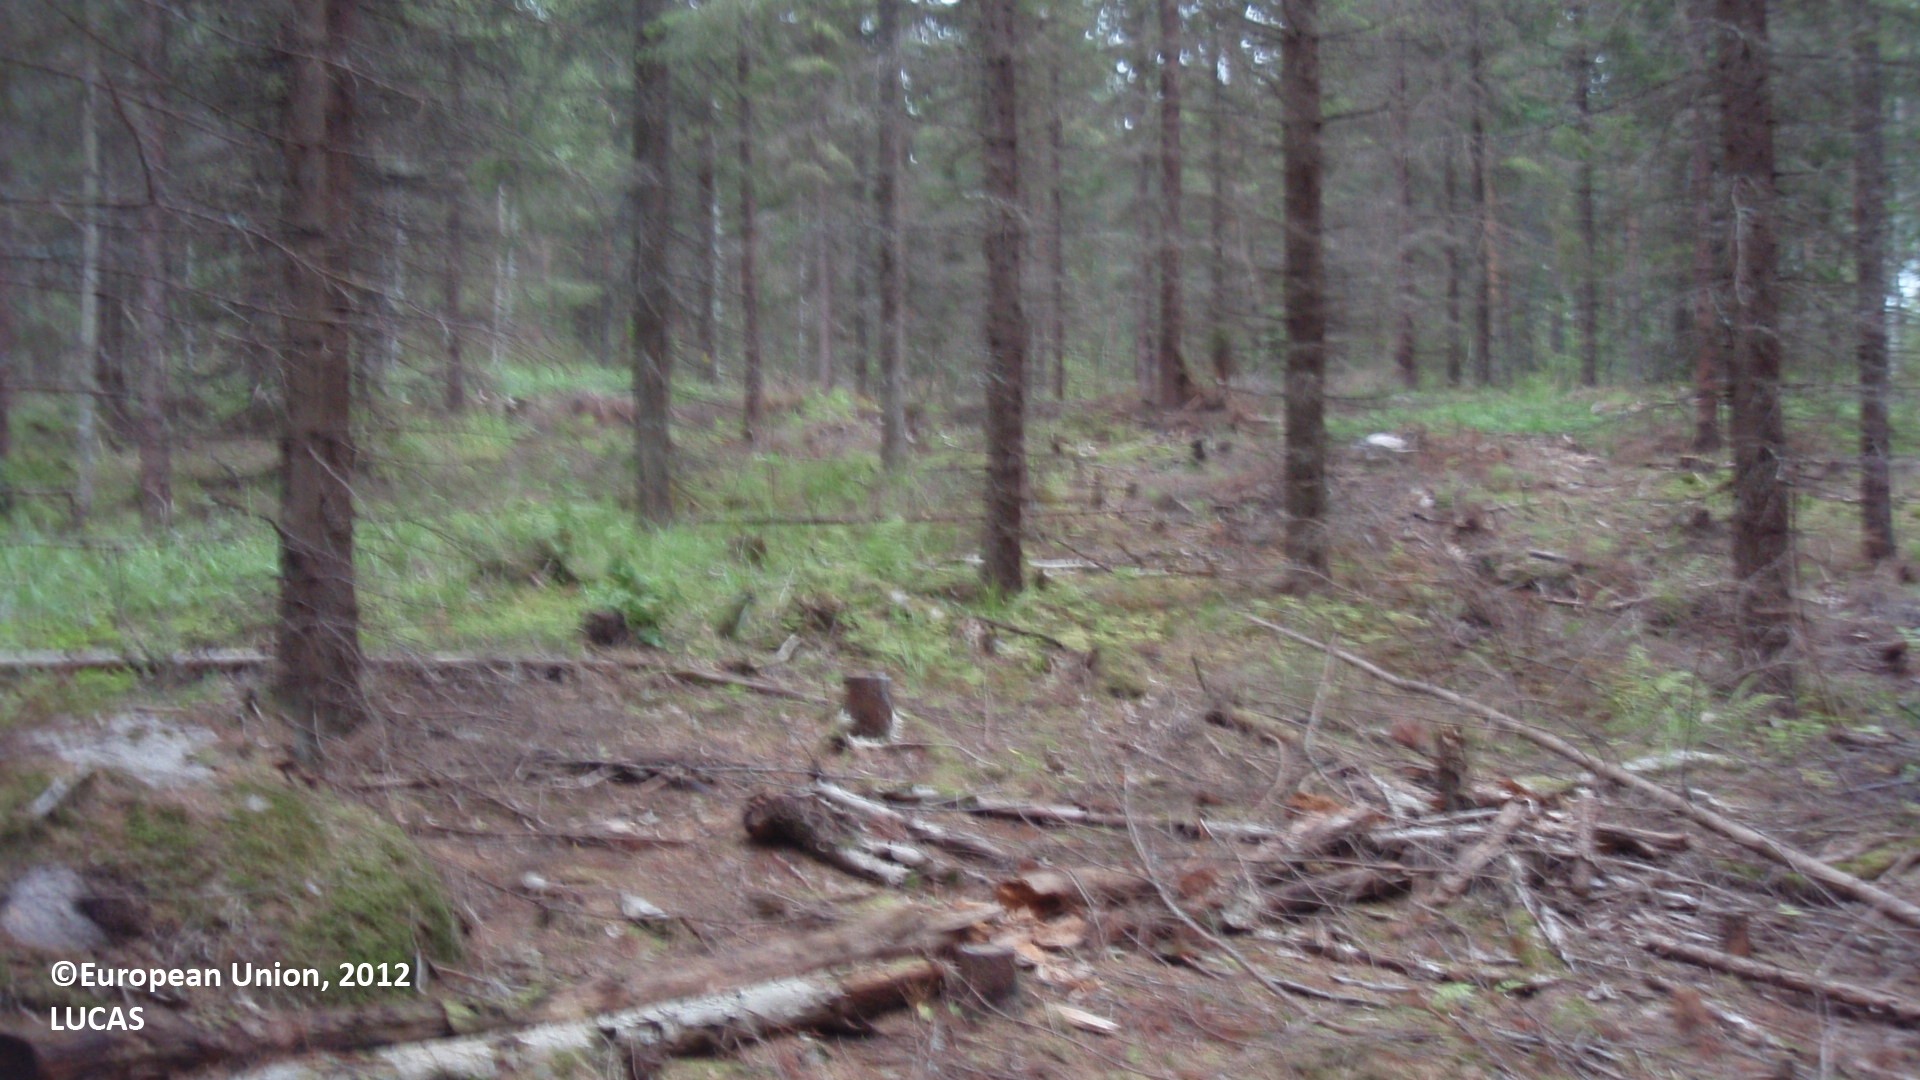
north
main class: Woodland
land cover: Spruce dominated coniferous woodland
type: boreal forest
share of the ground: 50 - 75 %
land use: Forestry
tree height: > 5 m
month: August
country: FI
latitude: 61.1798
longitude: 26.6109
